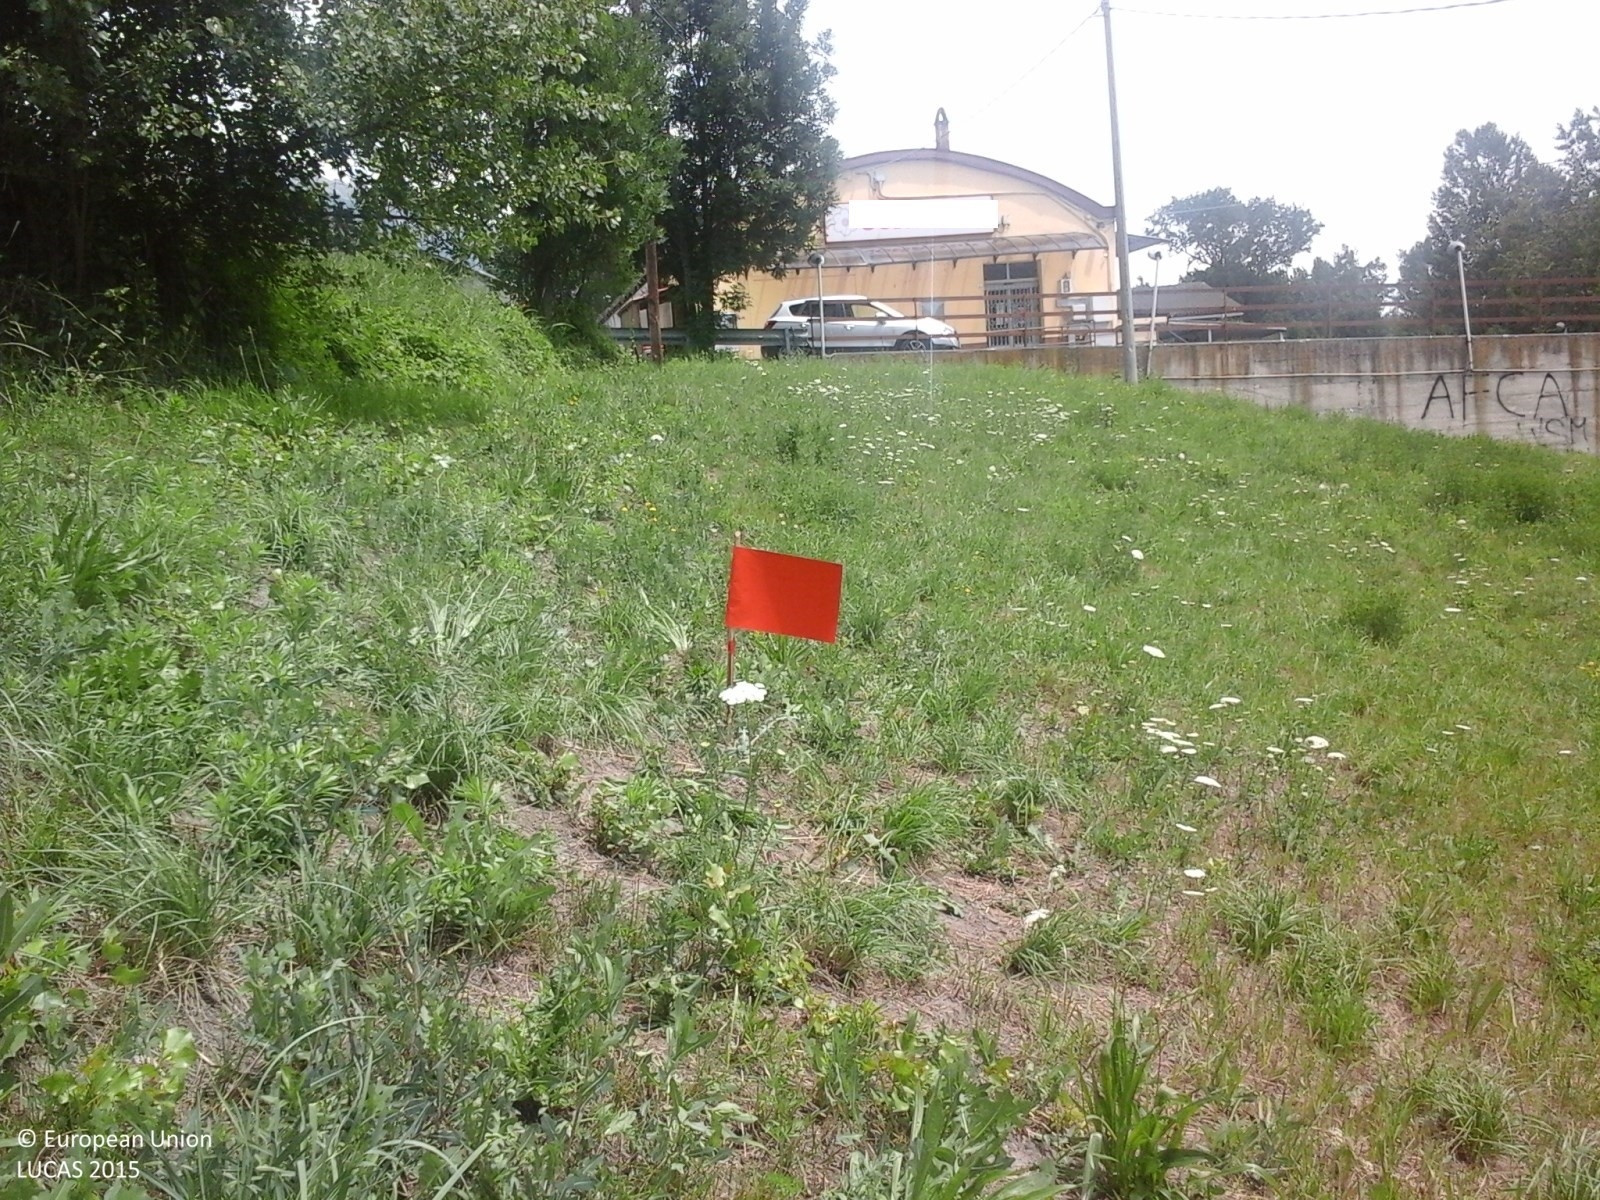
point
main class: Grassland
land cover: Grassland without tree/shrub cover
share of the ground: > 75 %
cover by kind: herbaceous plants 85 %, unconsolidated bare surface 15 %
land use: Agriculture (excluding fallow land and kitchen gardens)
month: June
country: IT
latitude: 45.7215
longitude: 7.2671
